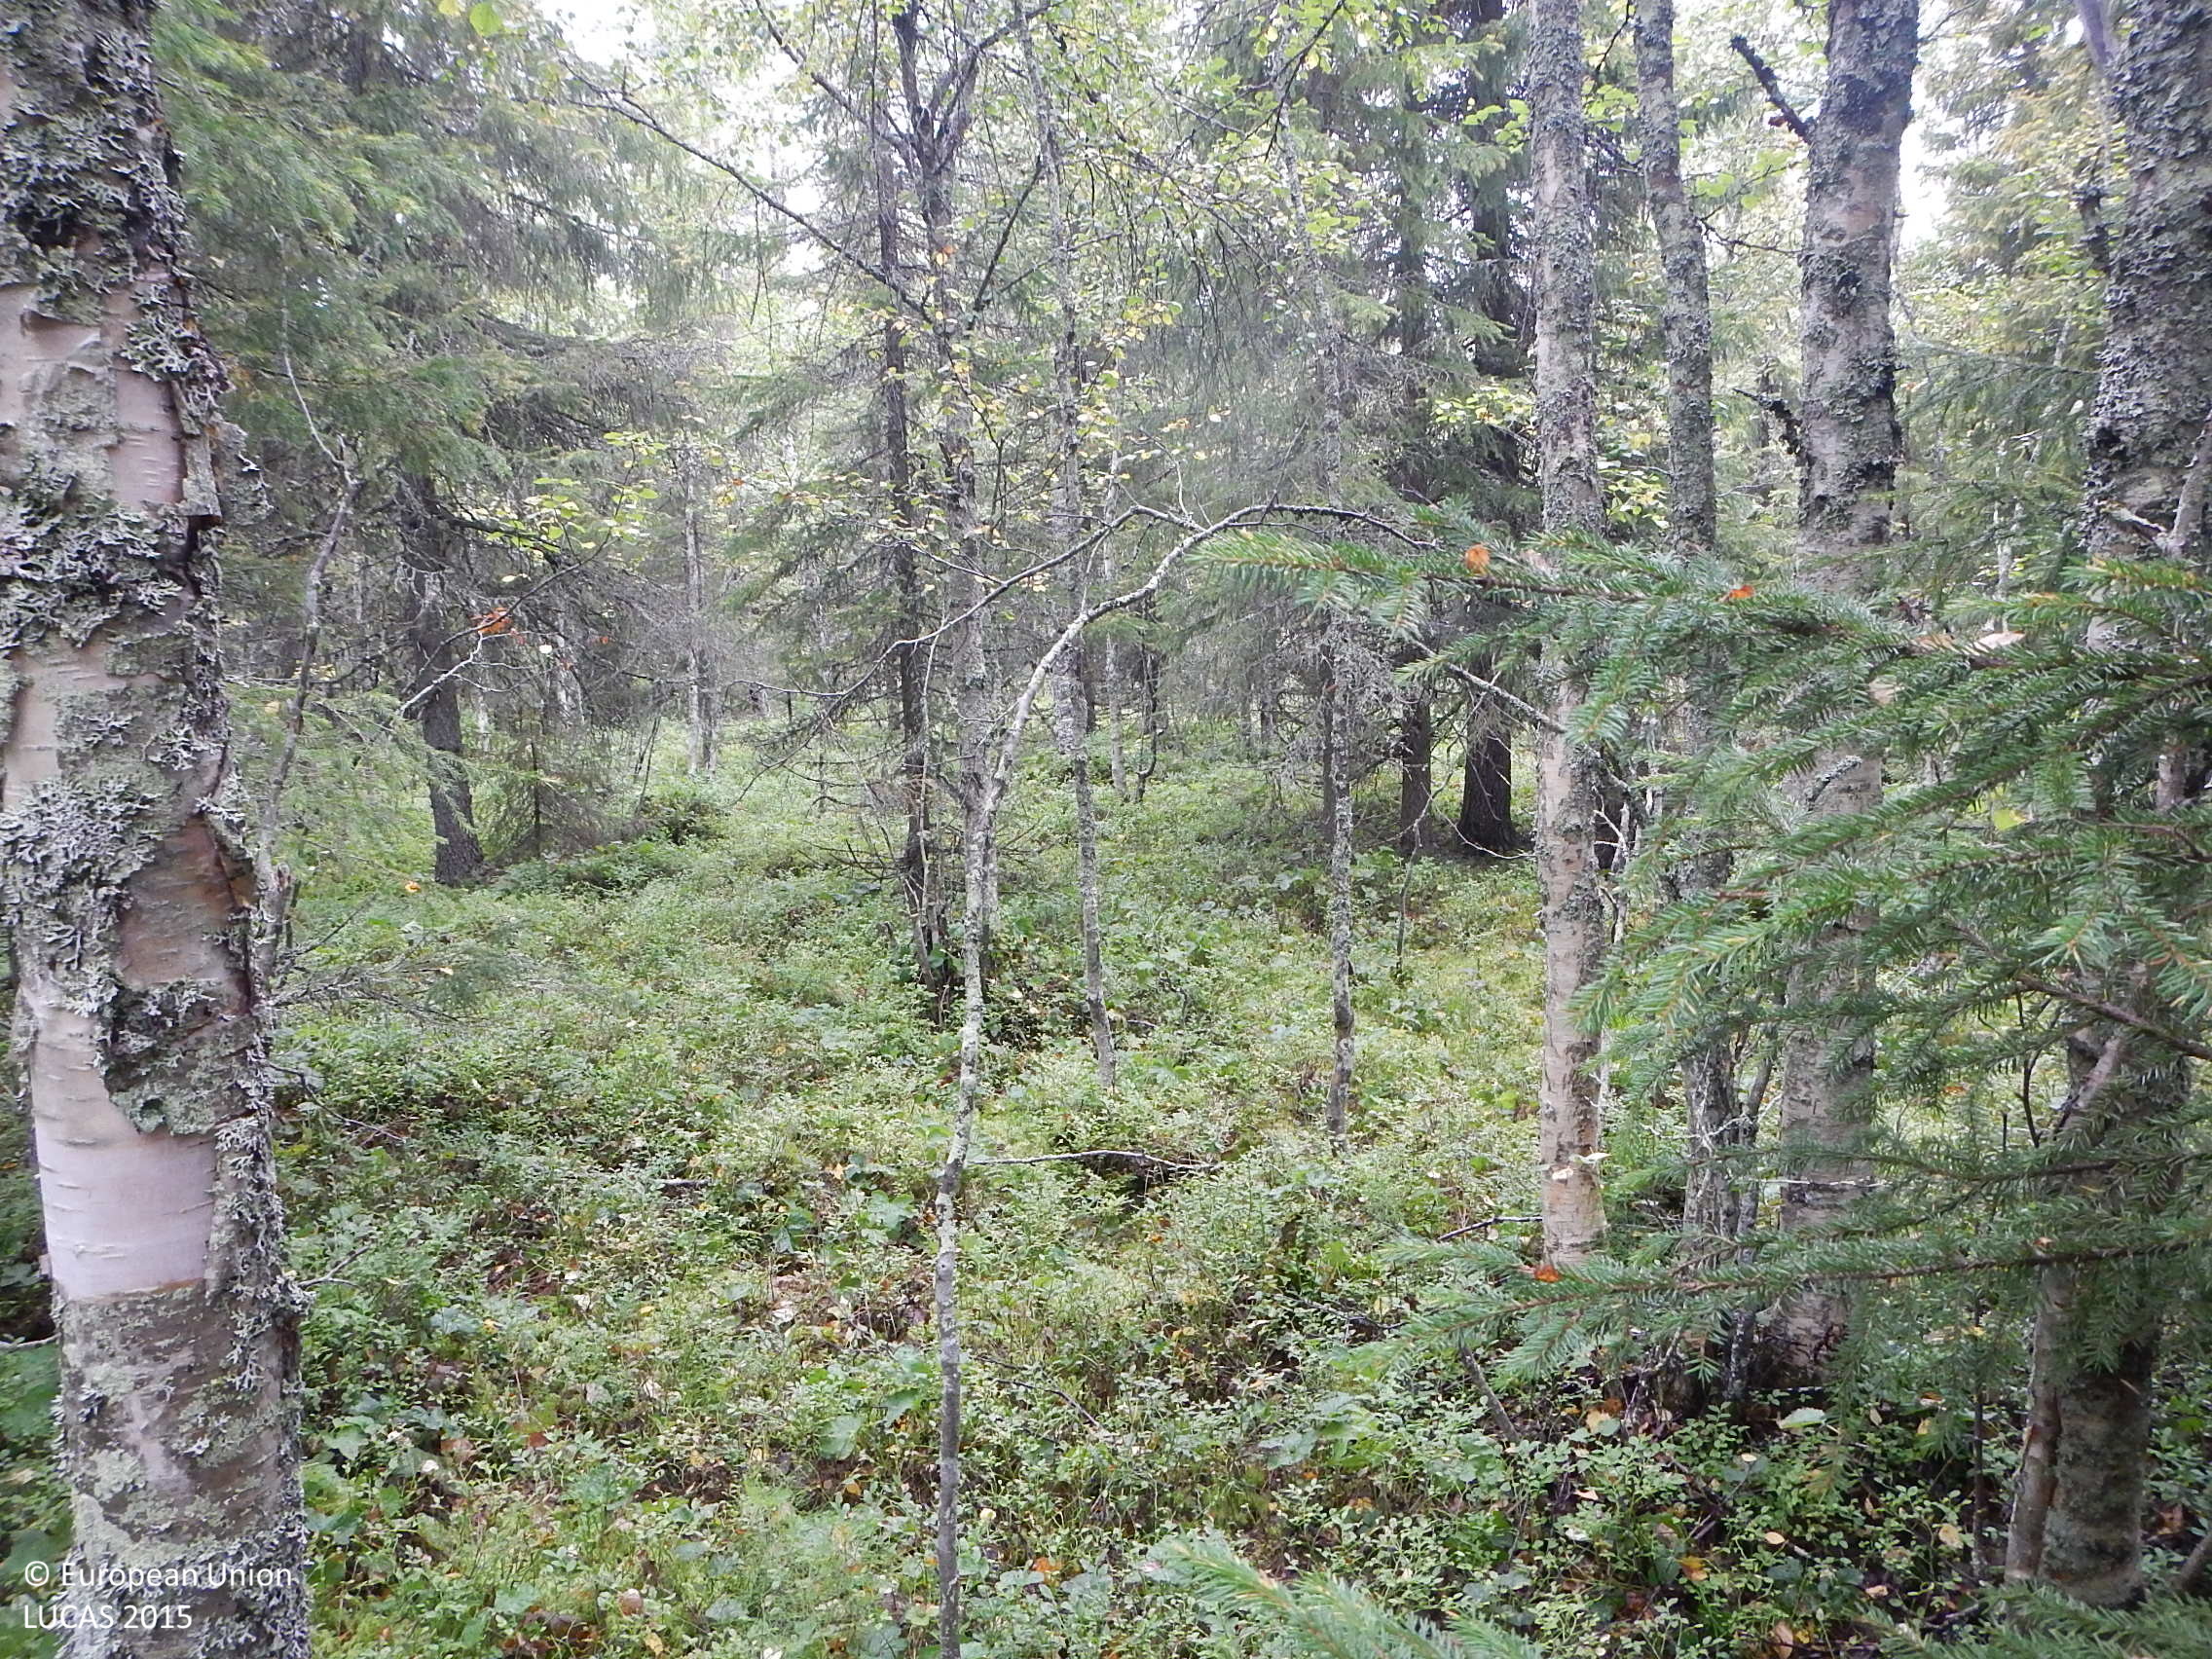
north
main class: Woodland
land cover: Spruce dominated mixed woodland
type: boreal forest
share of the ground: > 75 %
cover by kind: coniferous forest trees 55 %, broadleaved forest trees 30 %, shrubs 15 %
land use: Forestry
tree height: > 5 m
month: August
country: FI
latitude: 65.9071
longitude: 26.9910
